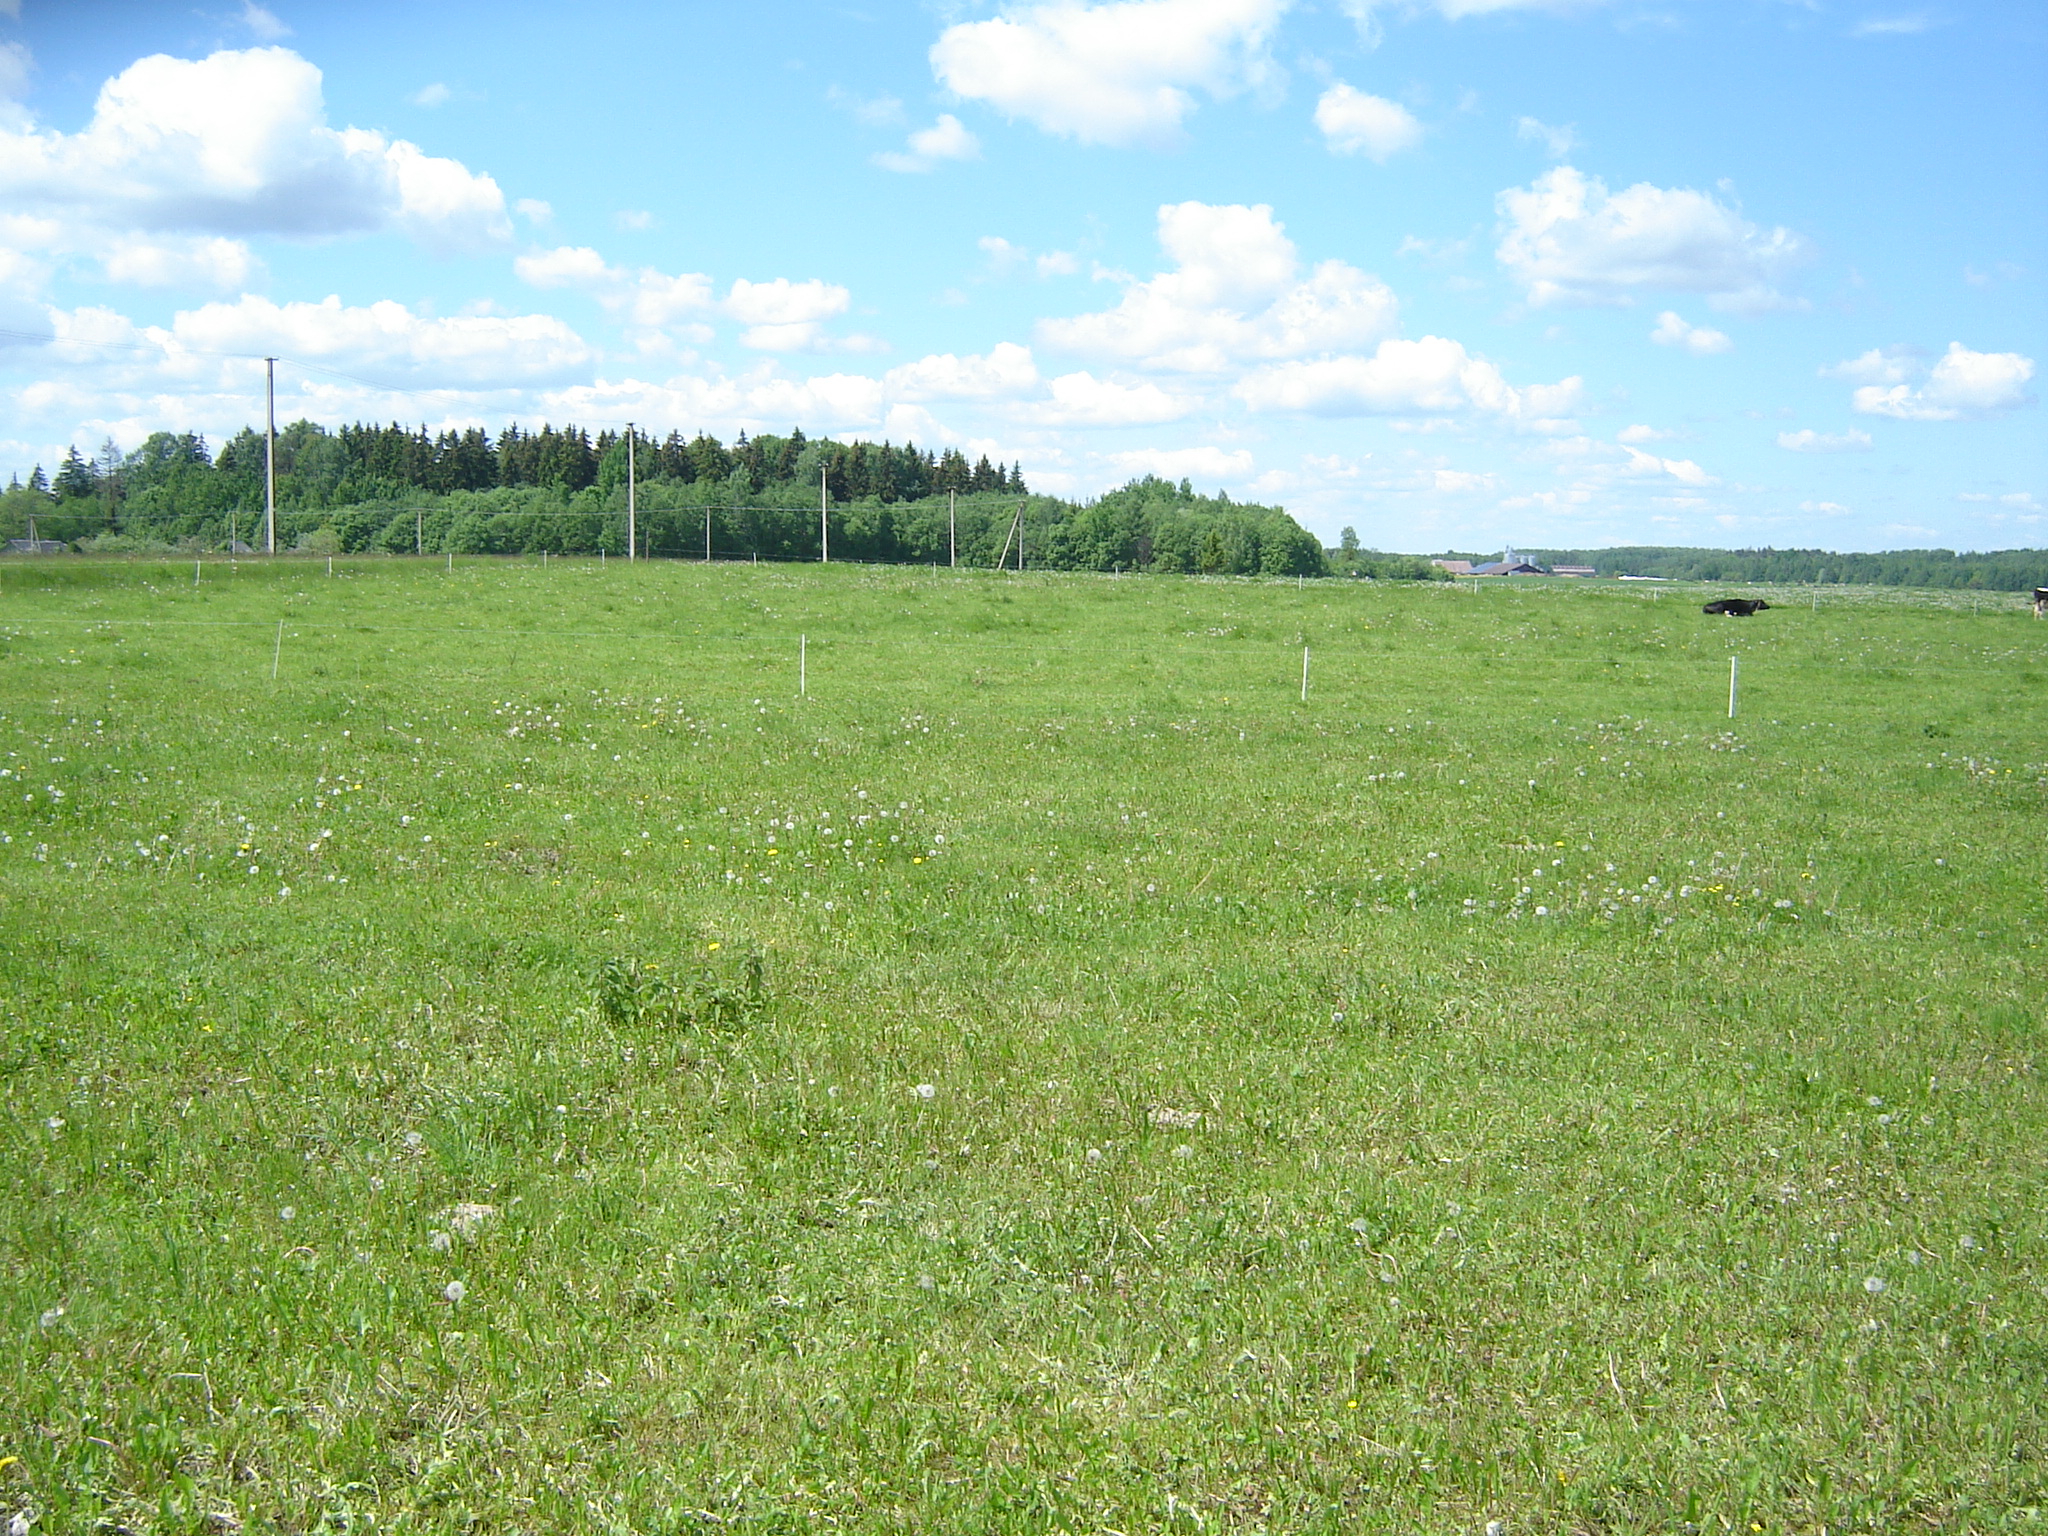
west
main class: Grassland
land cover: Grassland without tree/shrub cover
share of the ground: > 75 %
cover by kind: herbaceous plants 100 %
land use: Agriculture (excluding fallow land and kitchen gardens)
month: May
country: LT
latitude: 55.8070
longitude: 25.1931
